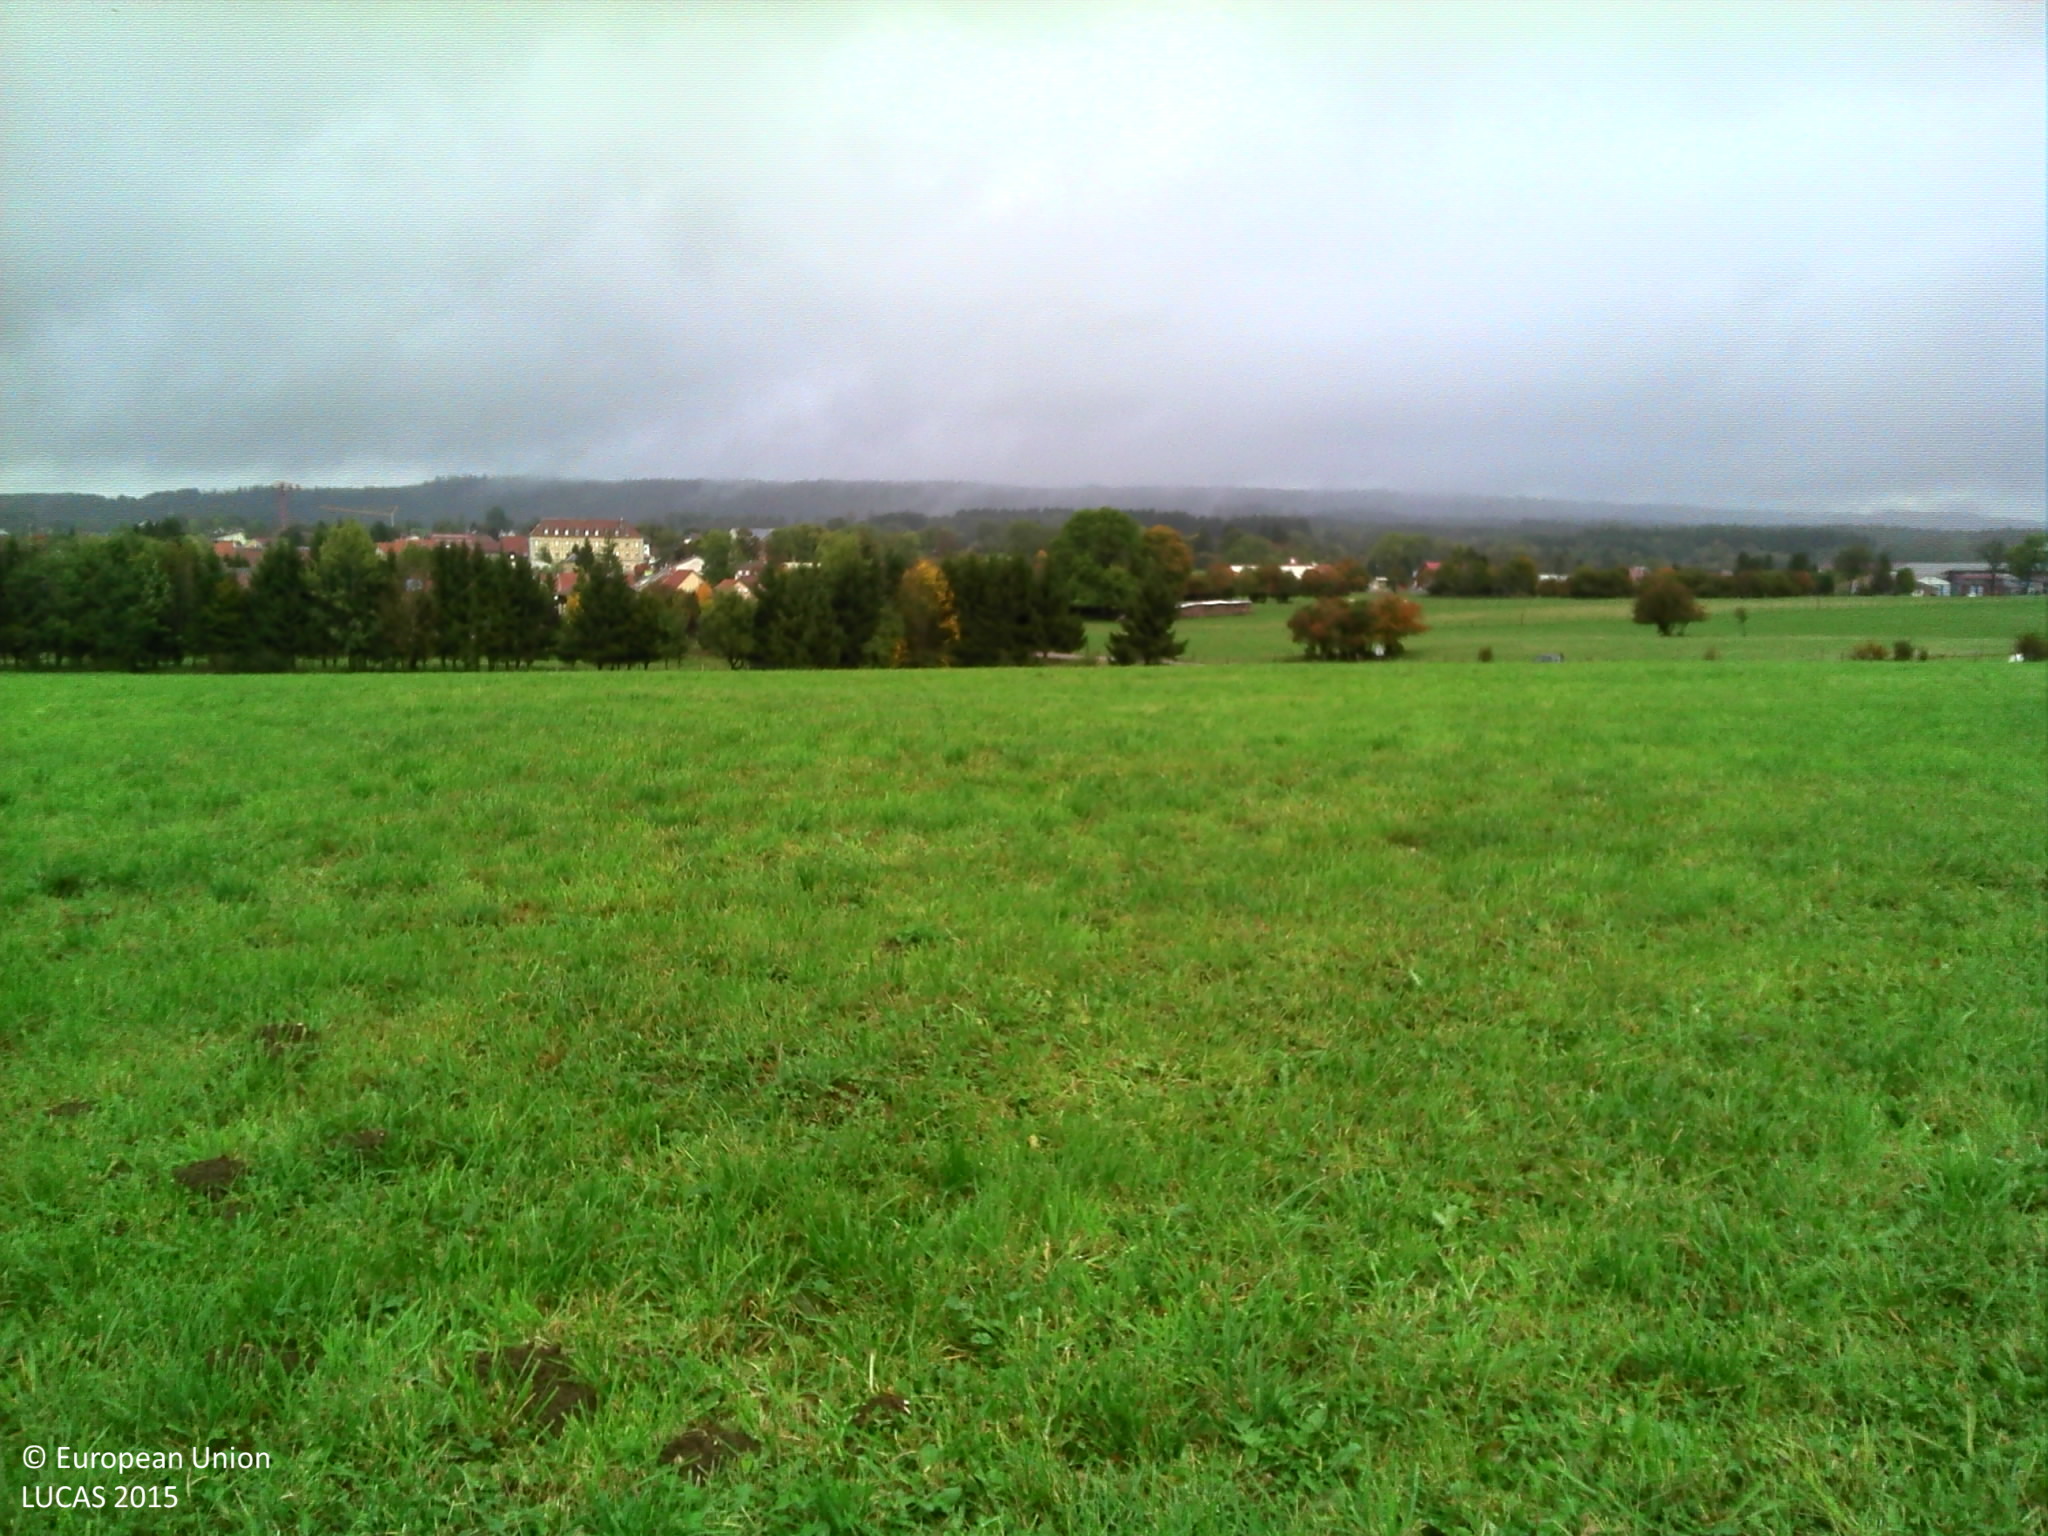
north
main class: Grassland
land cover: Grassland without tree/shrub cover
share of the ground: > 75 %
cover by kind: herbaceous plants 100 %
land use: Agriculture (excluding fallow land and kitchen gardens)
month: October
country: FR
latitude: 46.9481
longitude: 6.1264
